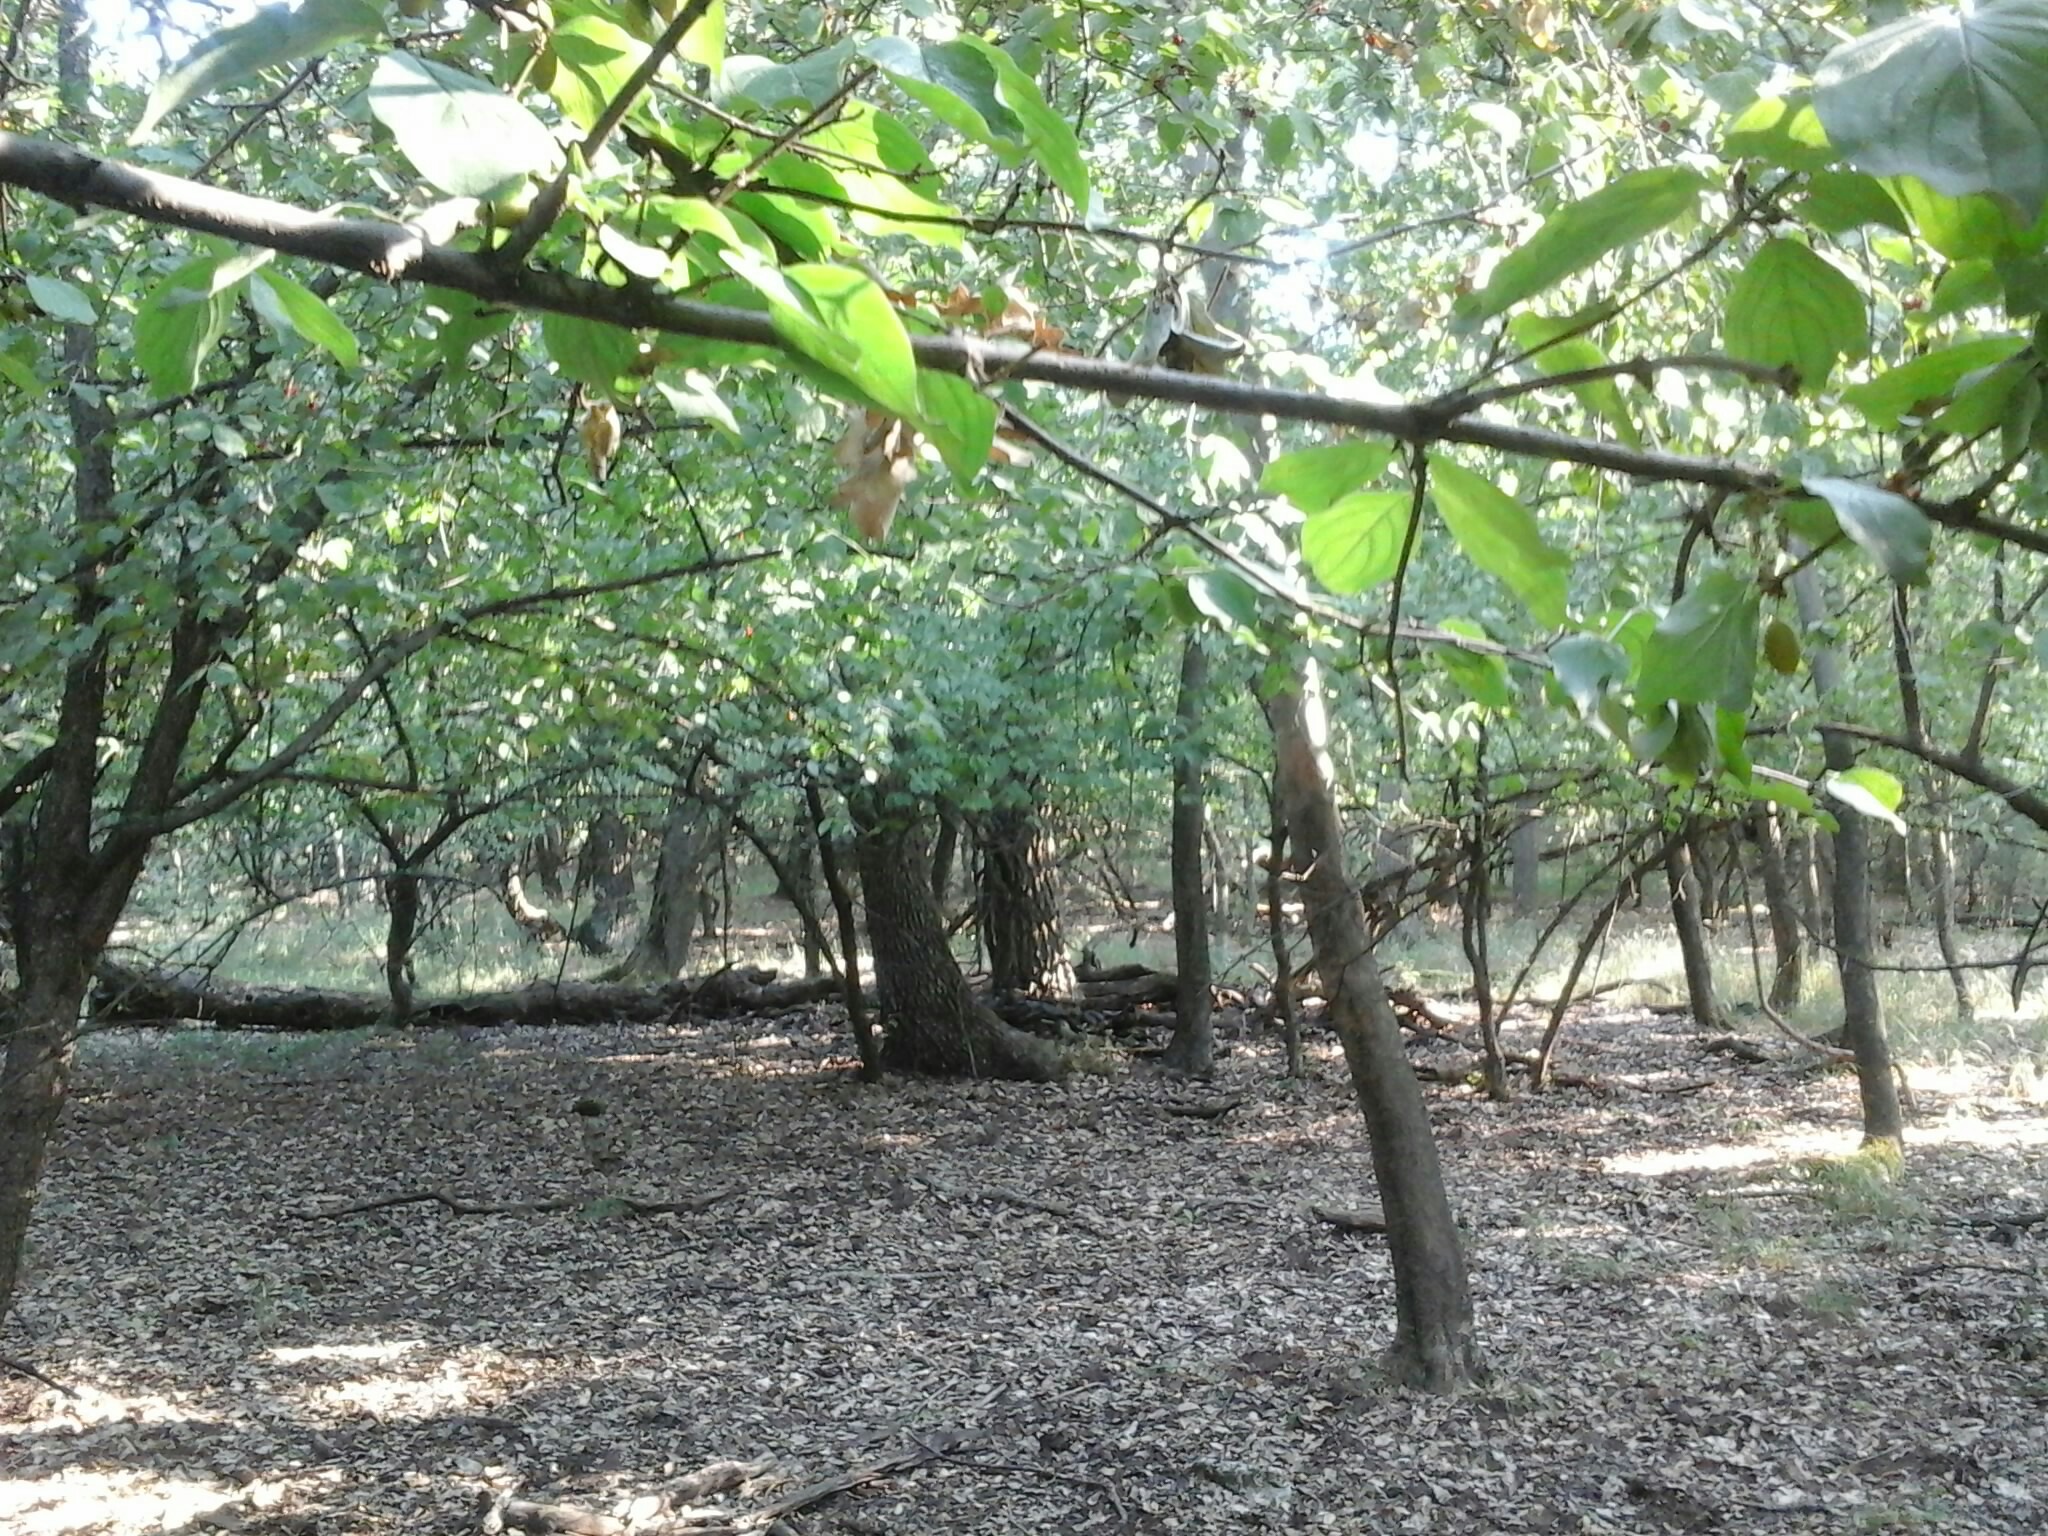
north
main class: Woodland
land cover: Broadleaved woodland
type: mesophytic deciduous forest
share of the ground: > 75 %
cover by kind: broadleaved forest trees 85 %, herbaceous plants 10 %, unconsolidated bare surface 5 %
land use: Forestry
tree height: > 5 m
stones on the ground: < 10 %
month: August
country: HU
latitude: 47.3822
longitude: 18.3440
